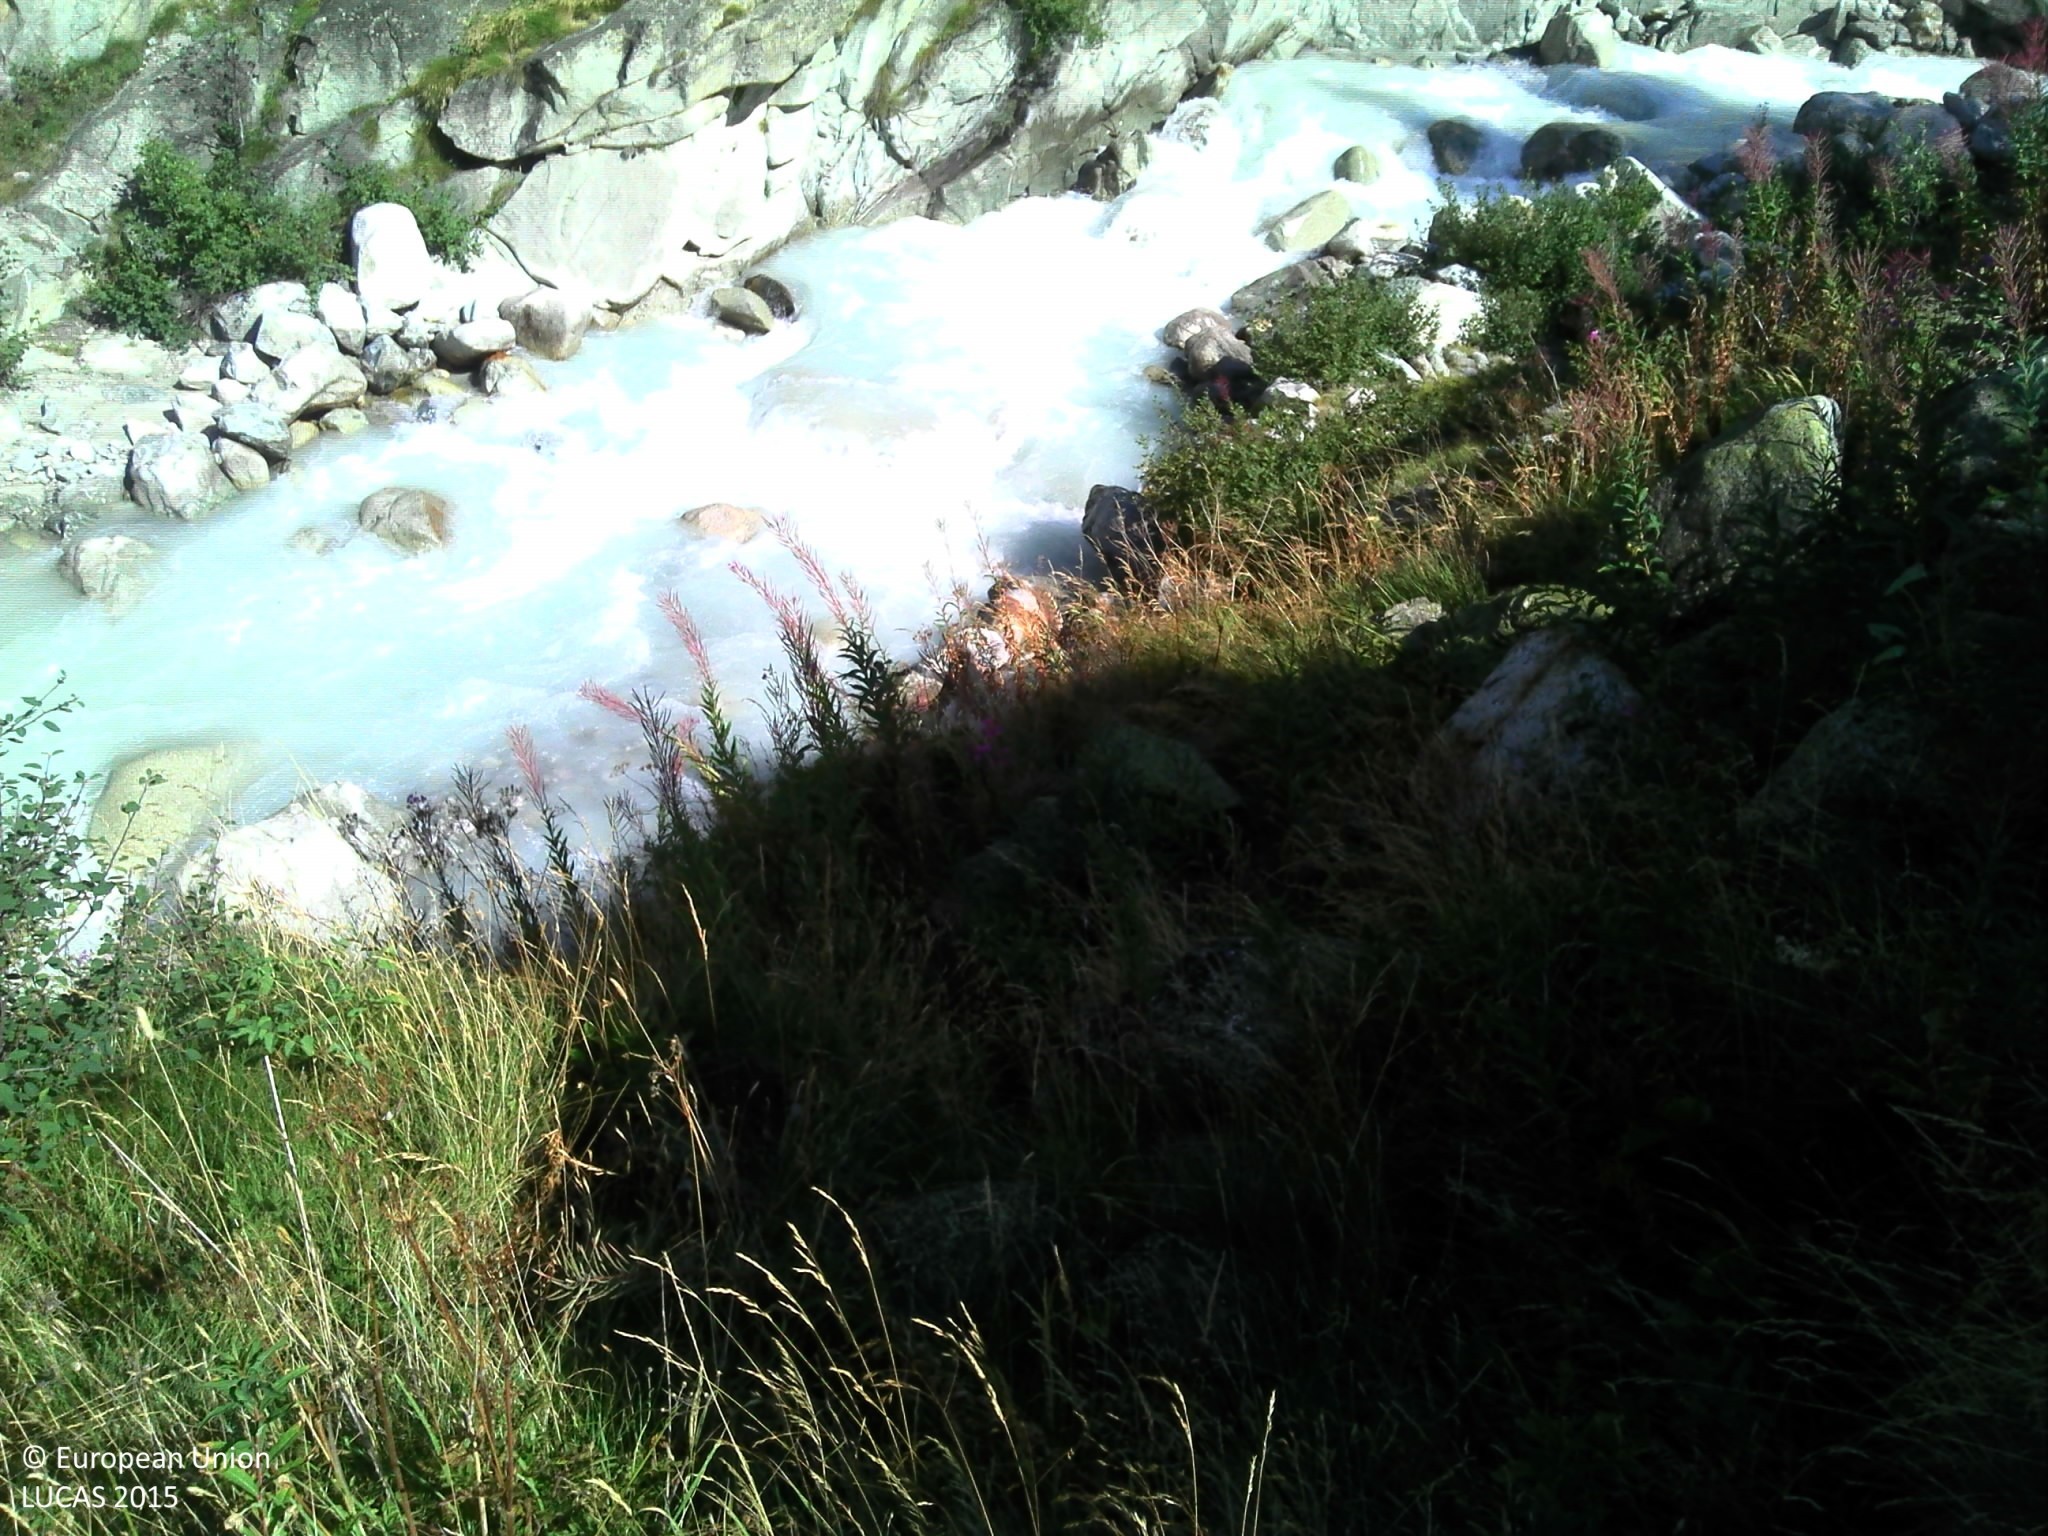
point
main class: Grassland
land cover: Grassland without tree/shrub cover
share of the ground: > 75 %
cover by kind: herbaceous plants 90 %, shrubs 5 %, unconsolidated bare surface 5 %
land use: Semi-natural and natural areas not in use
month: August
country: FR
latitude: 44.9342
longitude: 6.2930
